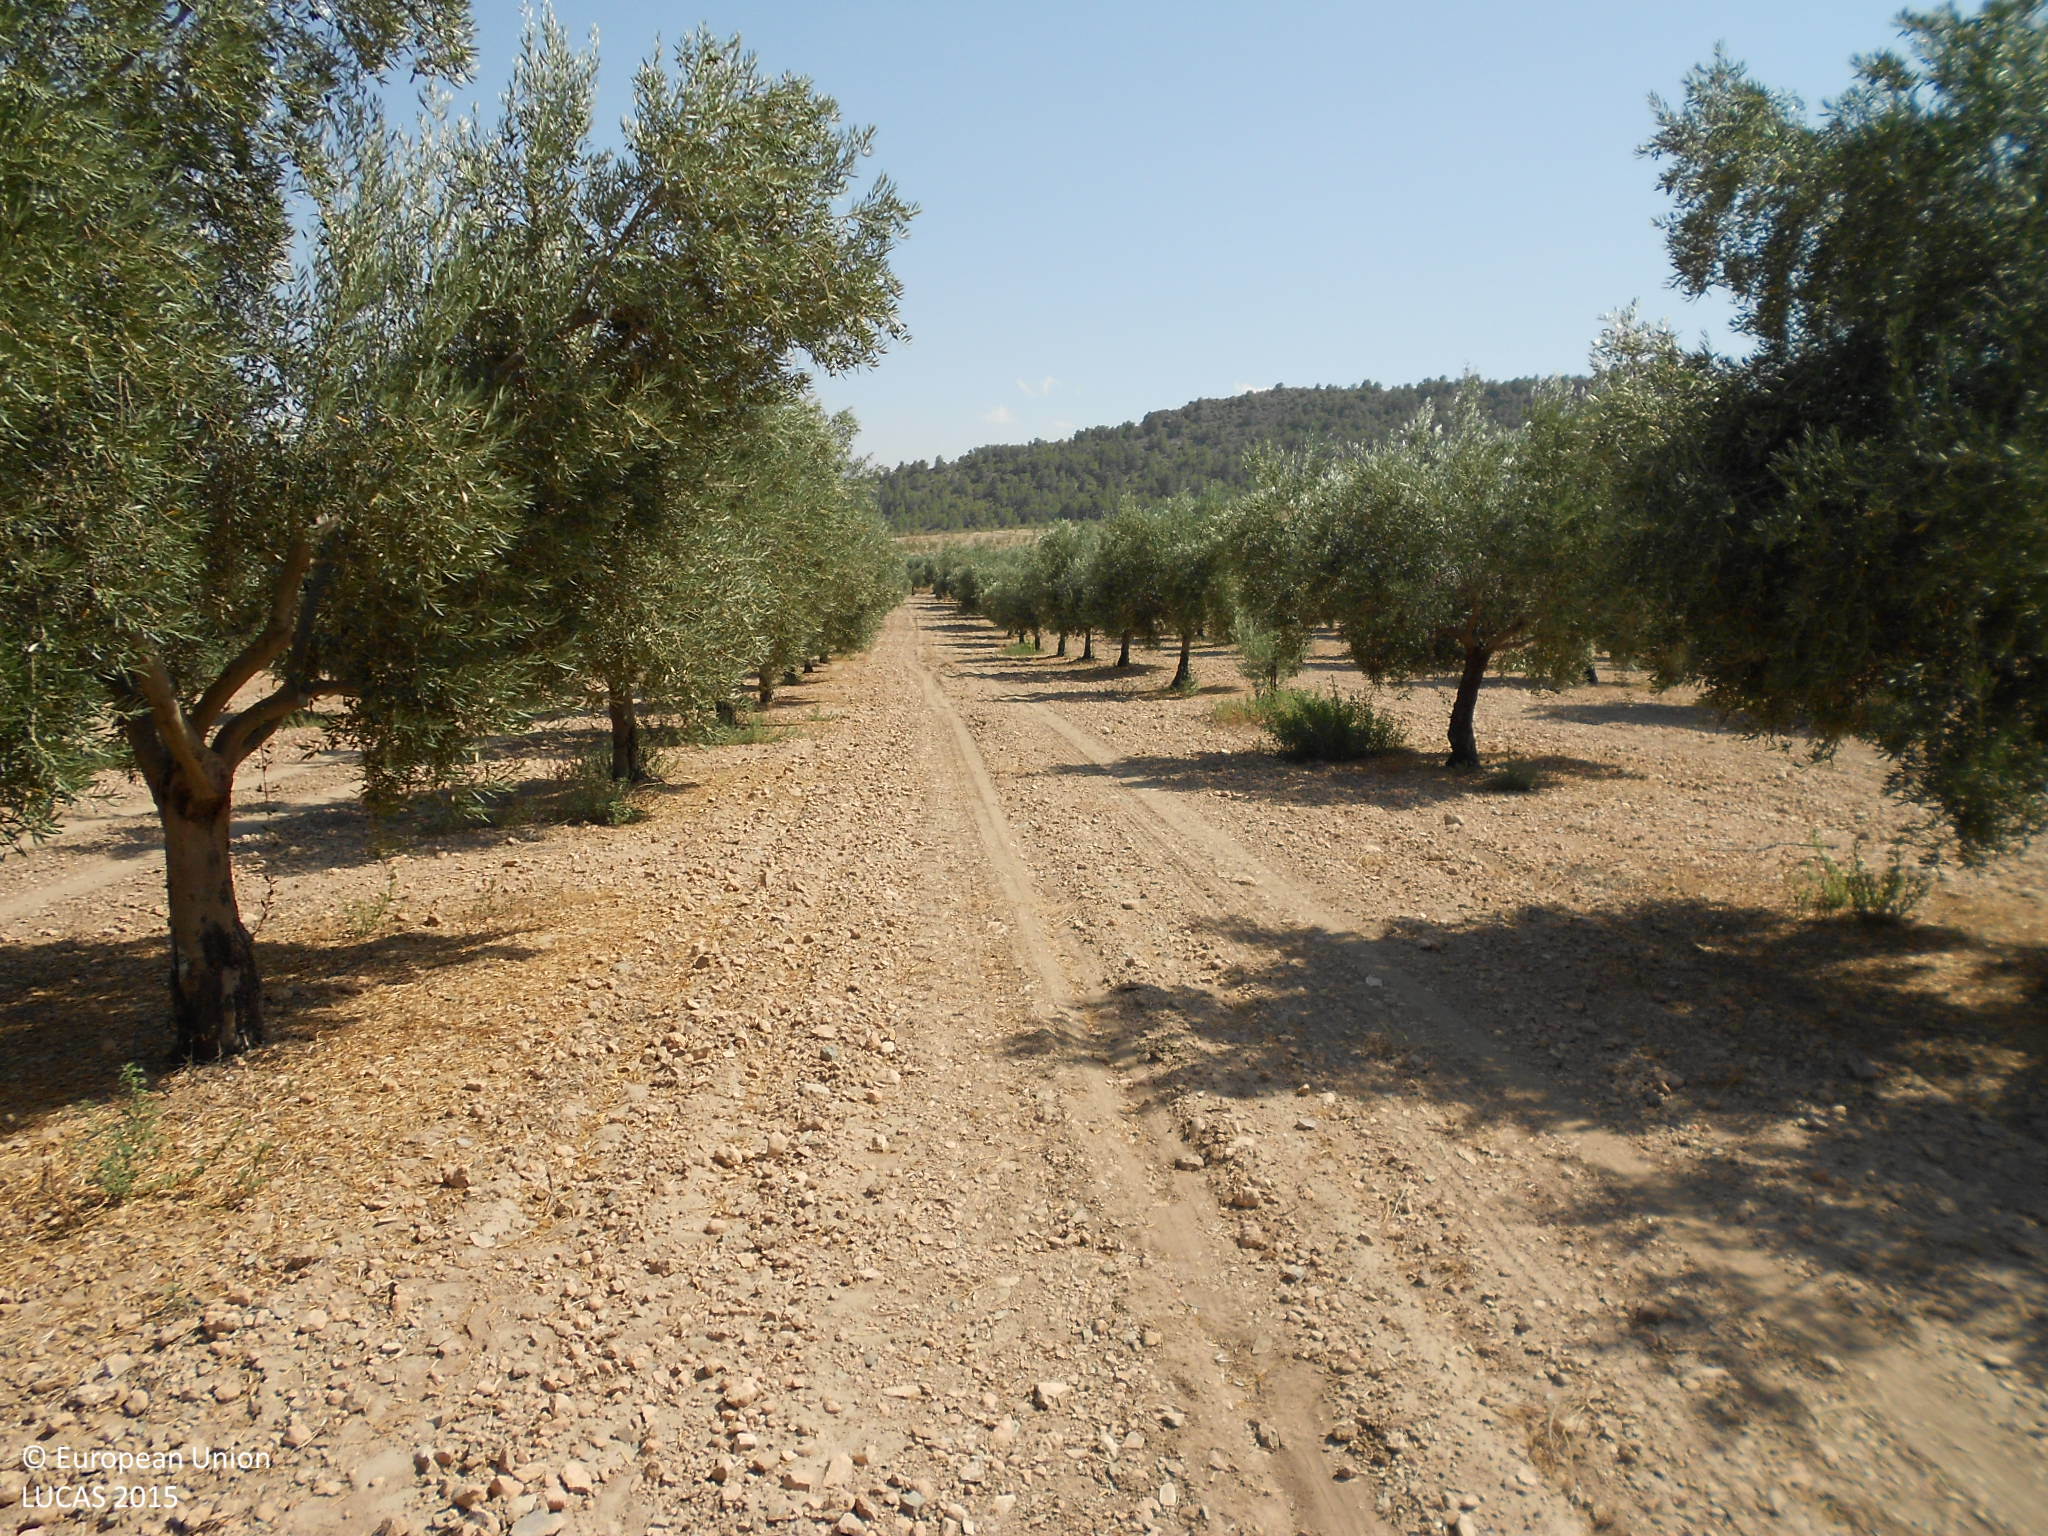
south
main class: Cropland
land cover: Olive groves
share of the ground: 50 - 75 %
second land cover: Other bare soil
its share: > 75 %
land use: Agriculture (excluding fallow land and kitchen gardens)
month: July
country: ES
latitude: 37.4508
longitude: -2.3615
